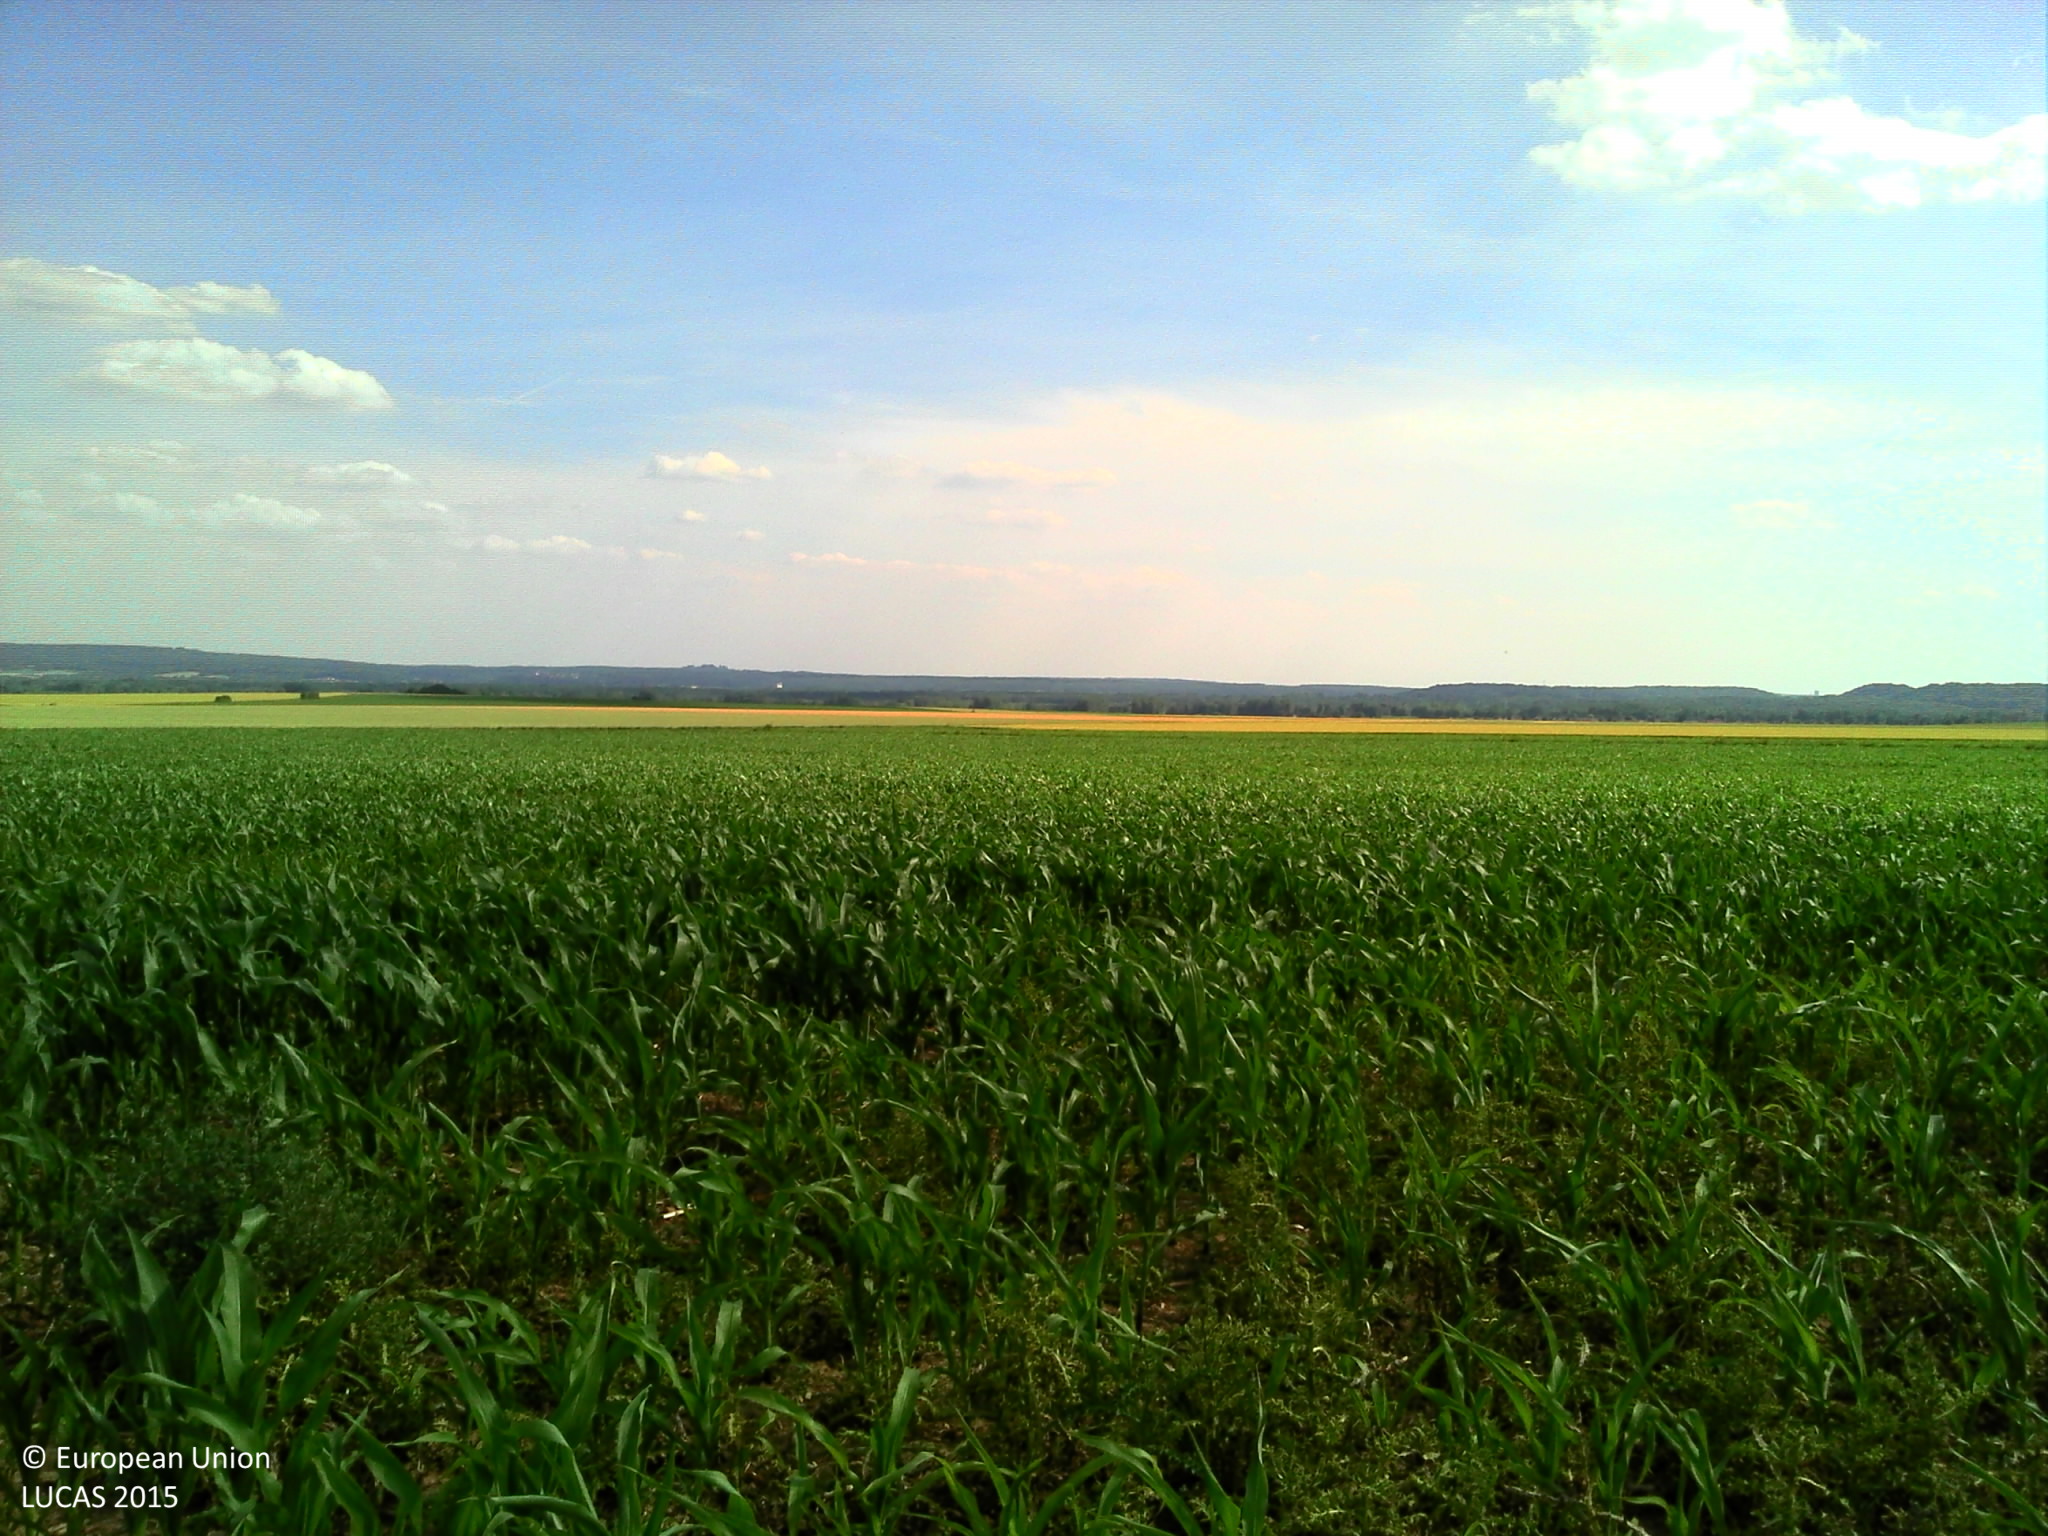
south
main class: Cropland
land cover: Maize
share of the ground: 50 - 75 %
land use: Agriculture (excluding fallow land and kitchen gardens)
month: June
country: FR
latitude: 49.3814
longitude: 2.5639
